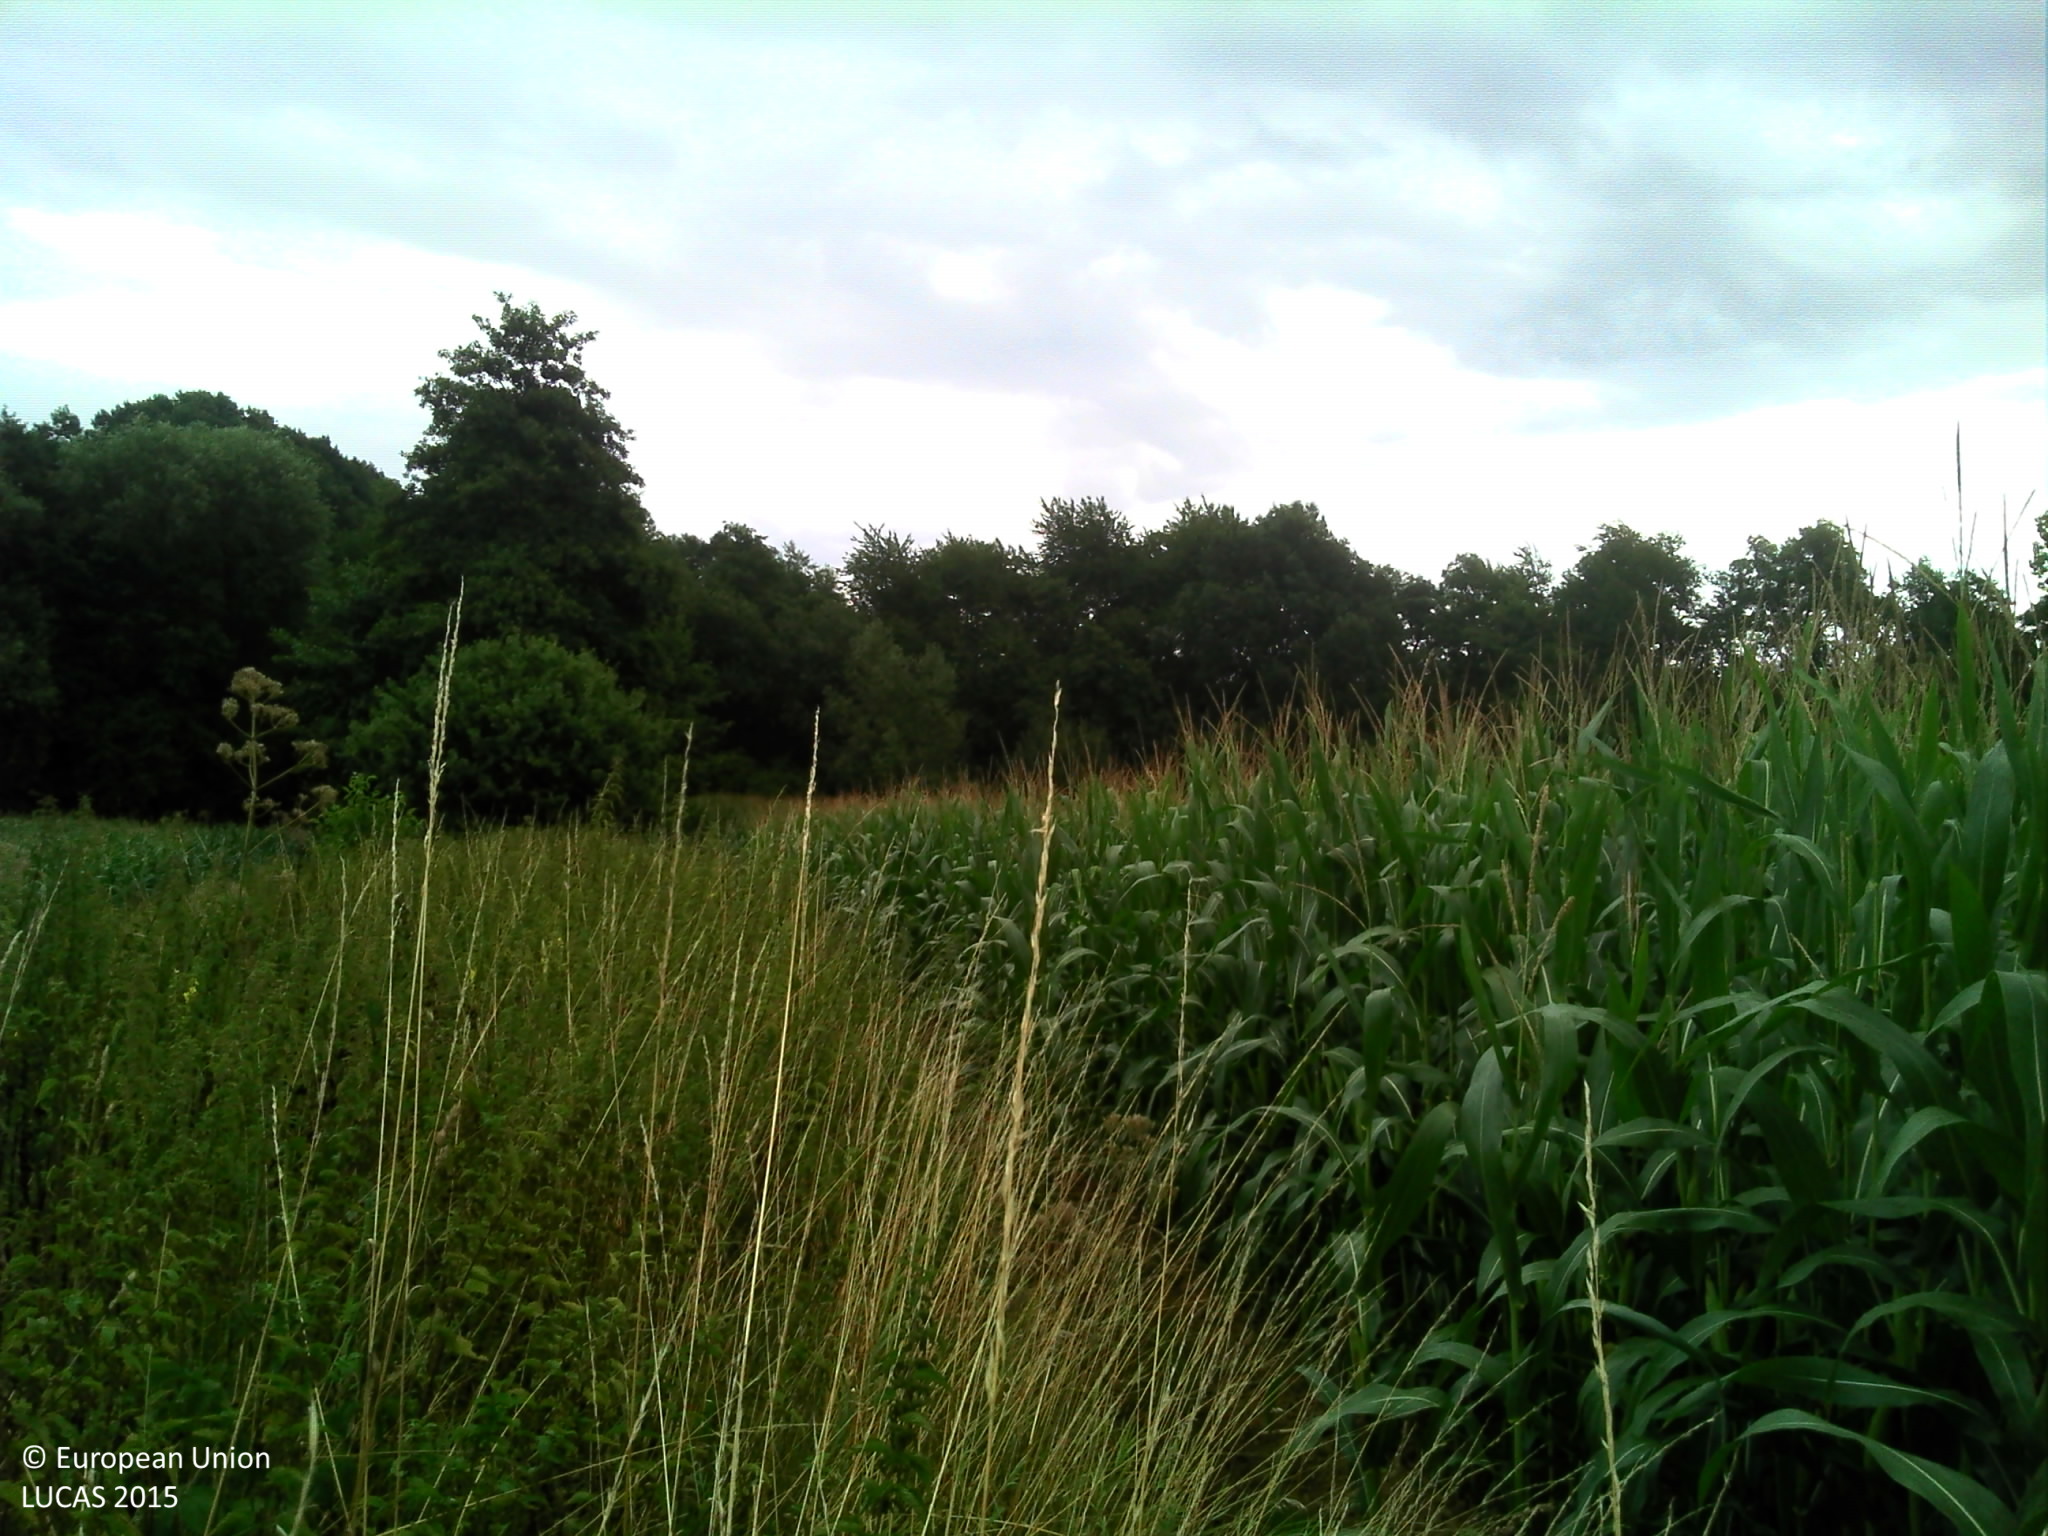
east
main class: Cropland
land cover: Maize
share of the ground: > 75 %
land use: Agriculture (excluding fallow land and kitchen gardens)
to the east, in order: Maize; Grass margins; Tracks; Spontaneously vegetated surfaces; Broadleaved woodland; Rivers and streams; Broadleaved woodland; Fences; Grassland without tree/shrub cover; Fences; Grassland with sparse tree/shrub cover; Fences; Grassland with sparse tree/shrub cover; Maize
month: July
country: FR
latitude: 48.9020
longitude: 7.7224
